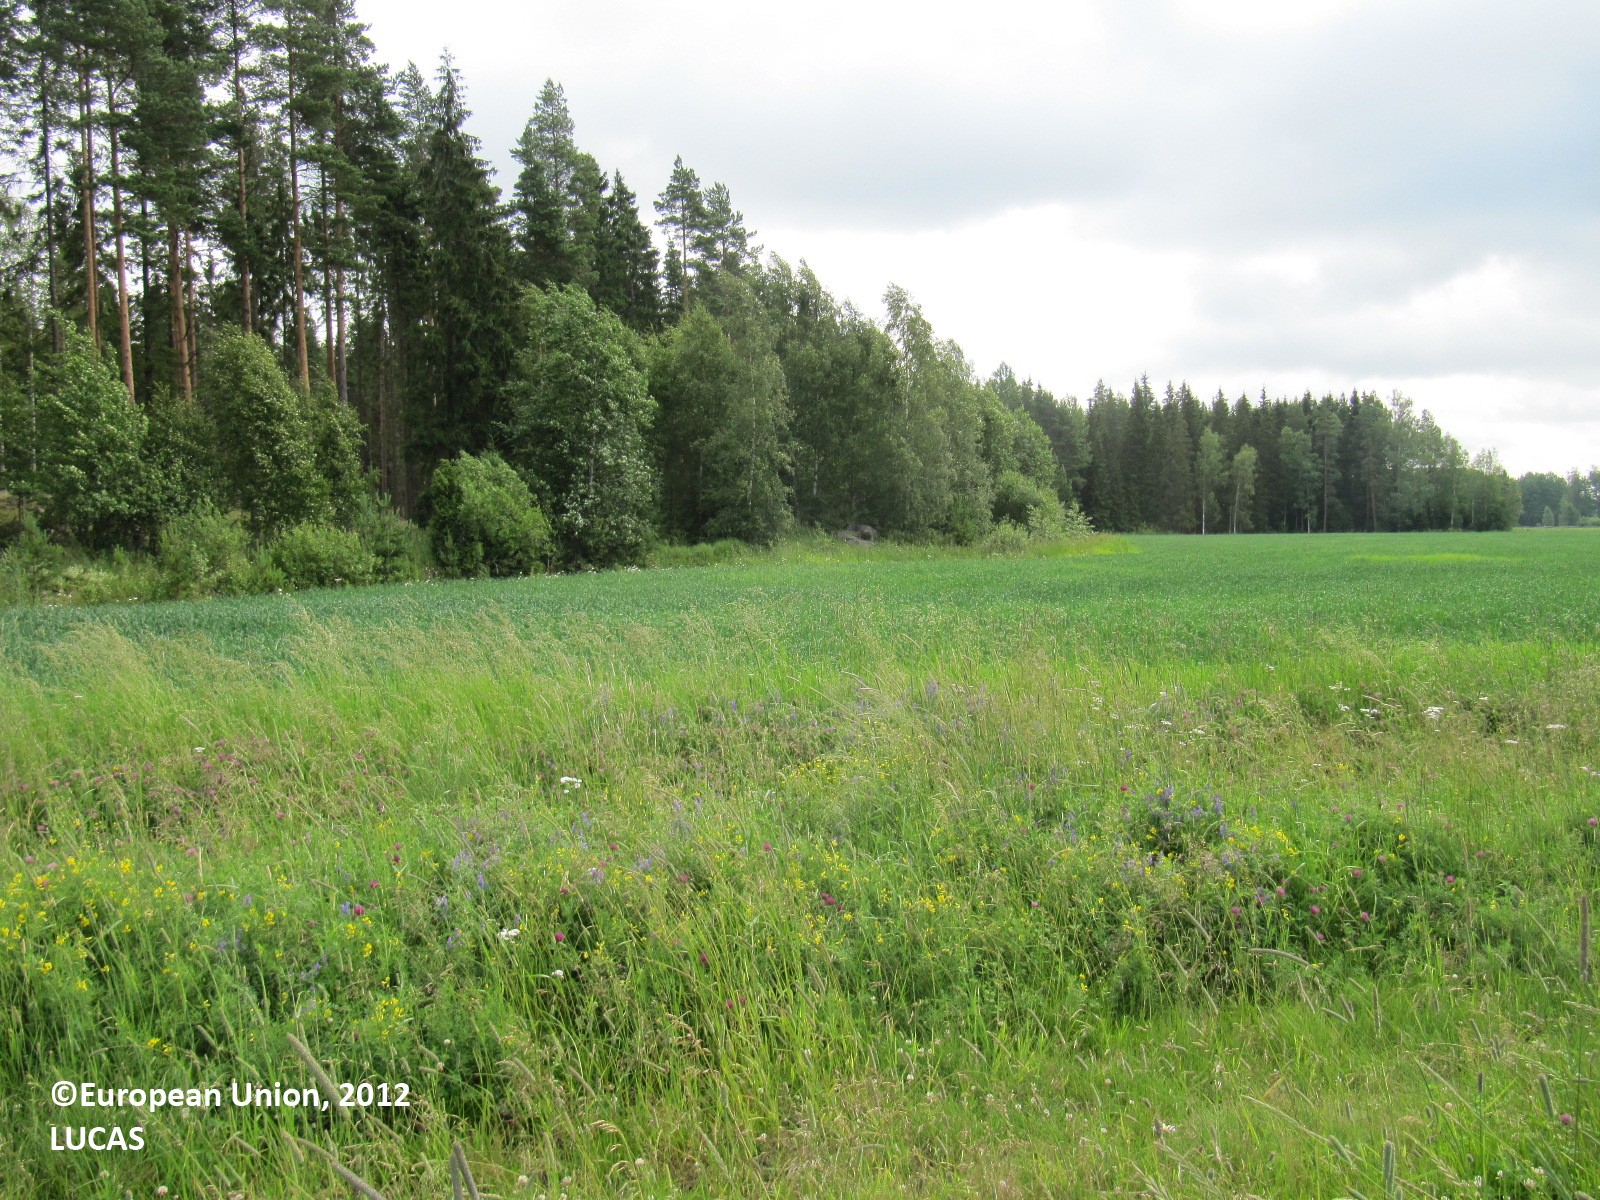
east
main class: Cropland
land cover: Common wheat
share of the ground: > 75 %
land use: Agriculture (excluding fallow land and kitchen gardens)
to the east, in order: Common wheat; Grassland without tree/shrub cover; Ditches and canals; Barley
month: July
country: FI
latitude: 60.8277
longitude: 23.3044
